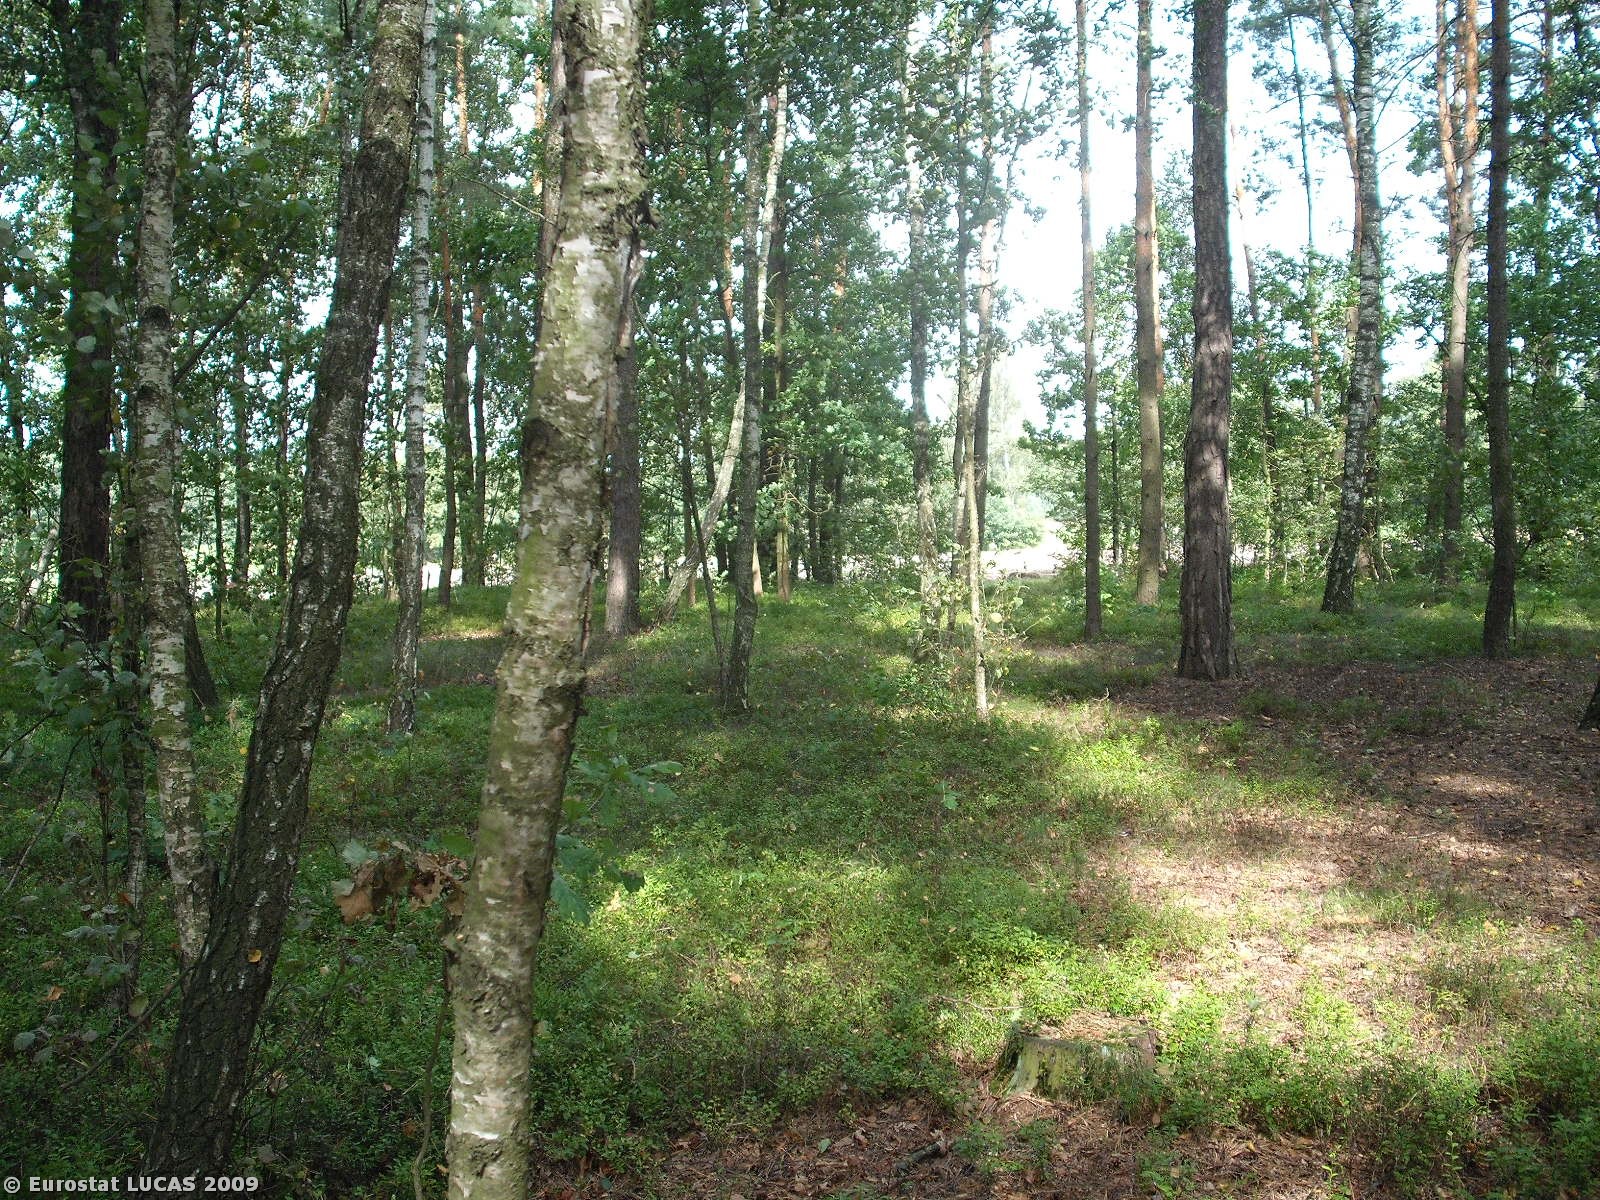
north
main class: Woodland
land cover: Mixed woodland
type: hemiboreal forest and nemoral coniferous forest and mixed broadleaved-coniferous forest
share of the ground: > 75 %
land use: Forestry
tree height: > 5 m
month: September
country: PL
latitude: 51.8827
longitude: 22.1036
